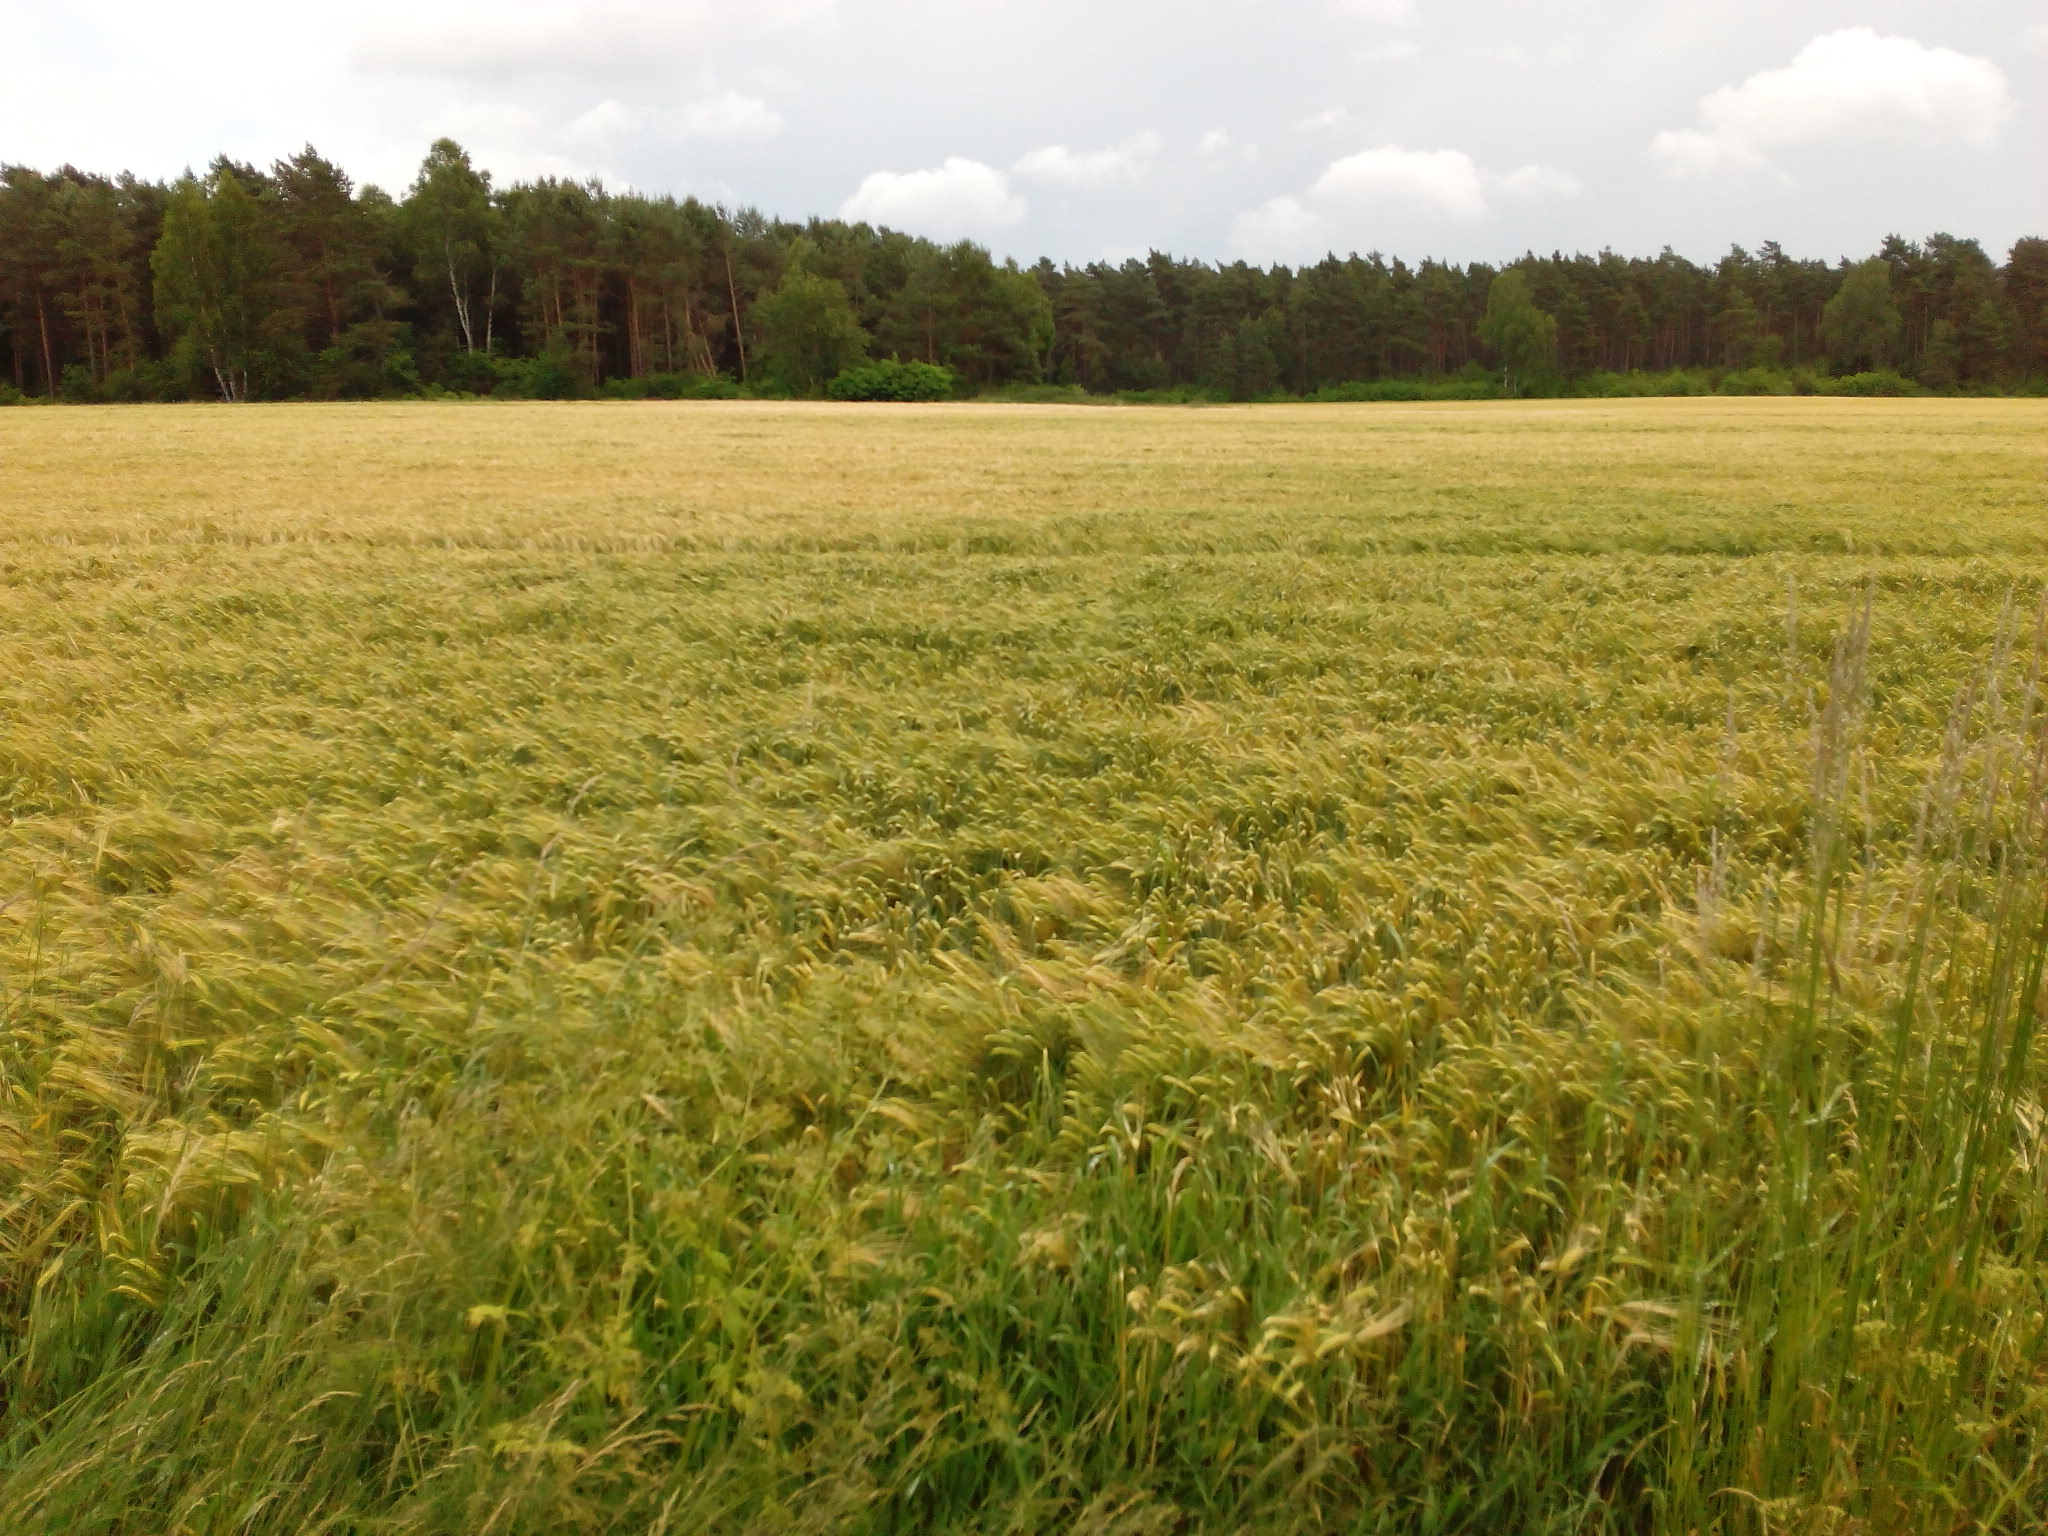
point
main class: Cropland
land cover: Barley
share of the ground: > 75 %
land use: Agriculture (excluding fallow land and kitchen gardens)
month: June
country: DE
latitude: 52.7728
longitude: 9.9259
